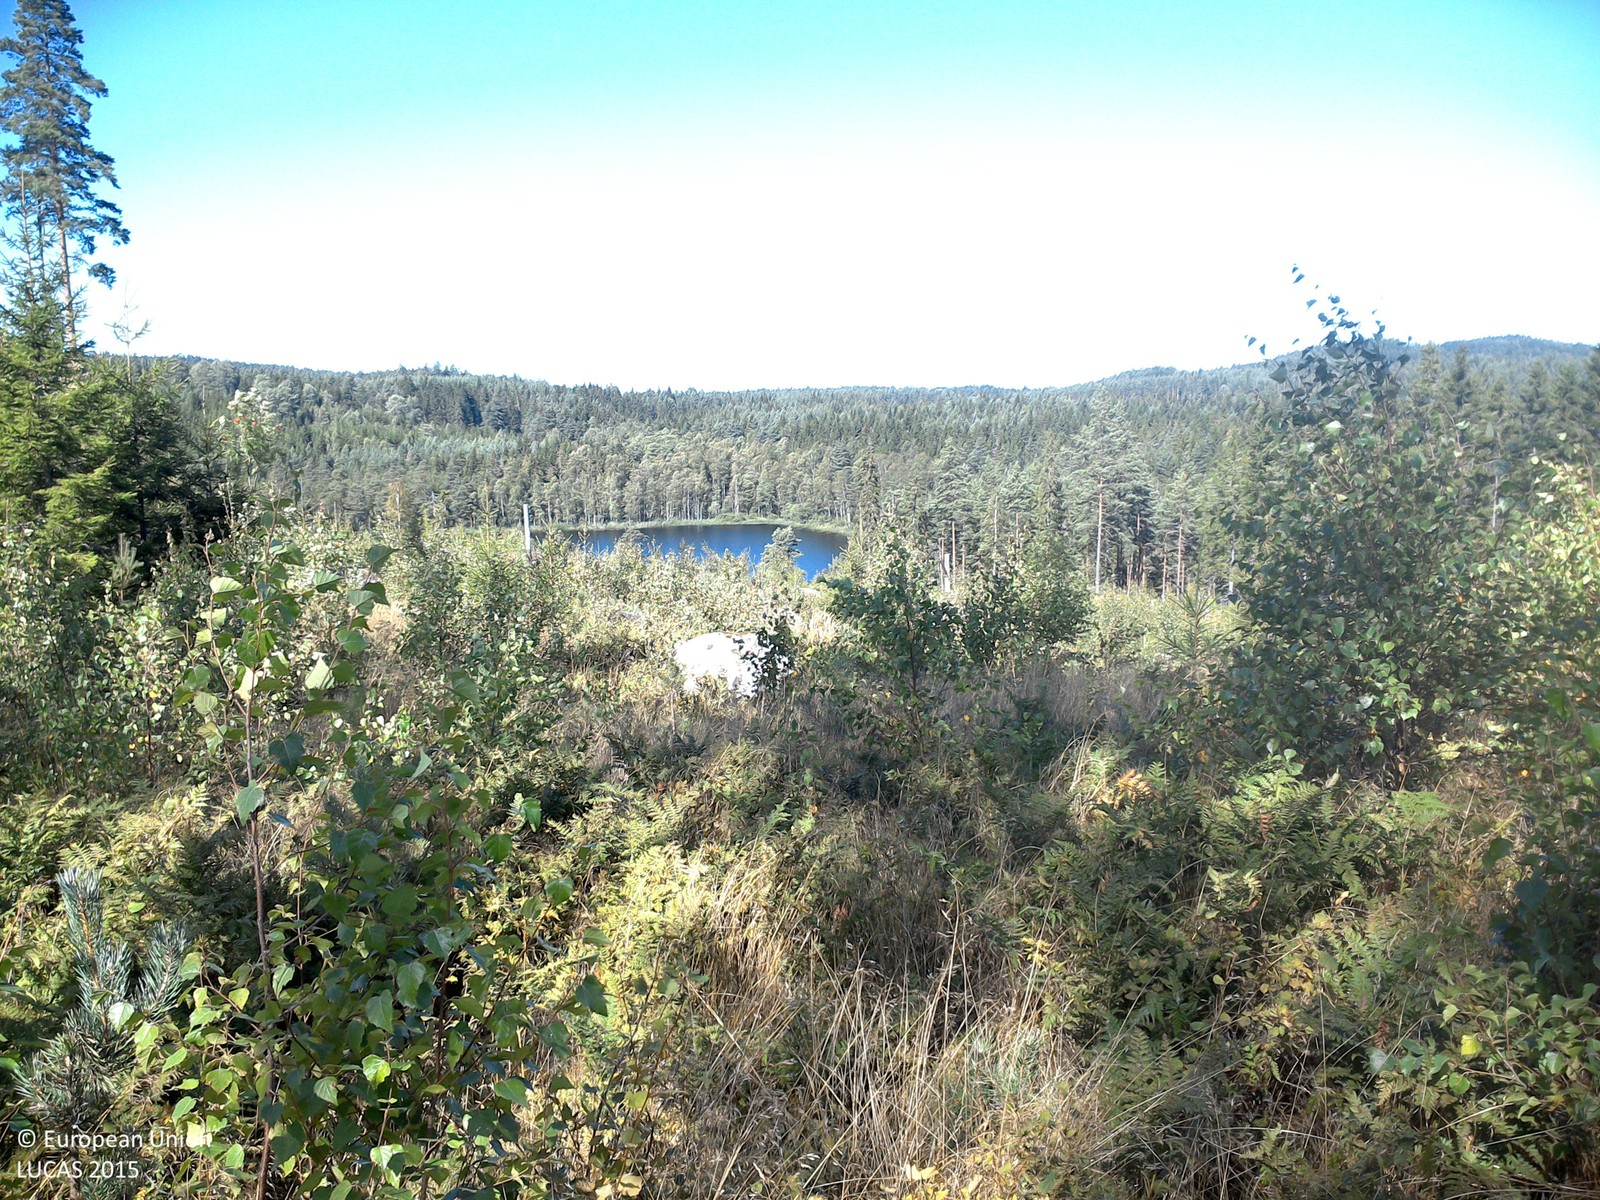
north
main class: Woodland
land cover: Broadleaved woodland
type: boreal forest
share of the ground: 25 - 50 %
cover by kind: herbaceous plants 50 %, broadleaved forest trees 45 %, shrubs 5 %
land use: Forestry
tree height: < 5 m
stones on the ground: < 10 %
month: August
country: SE
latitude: 57.8611
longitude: 15.3384
